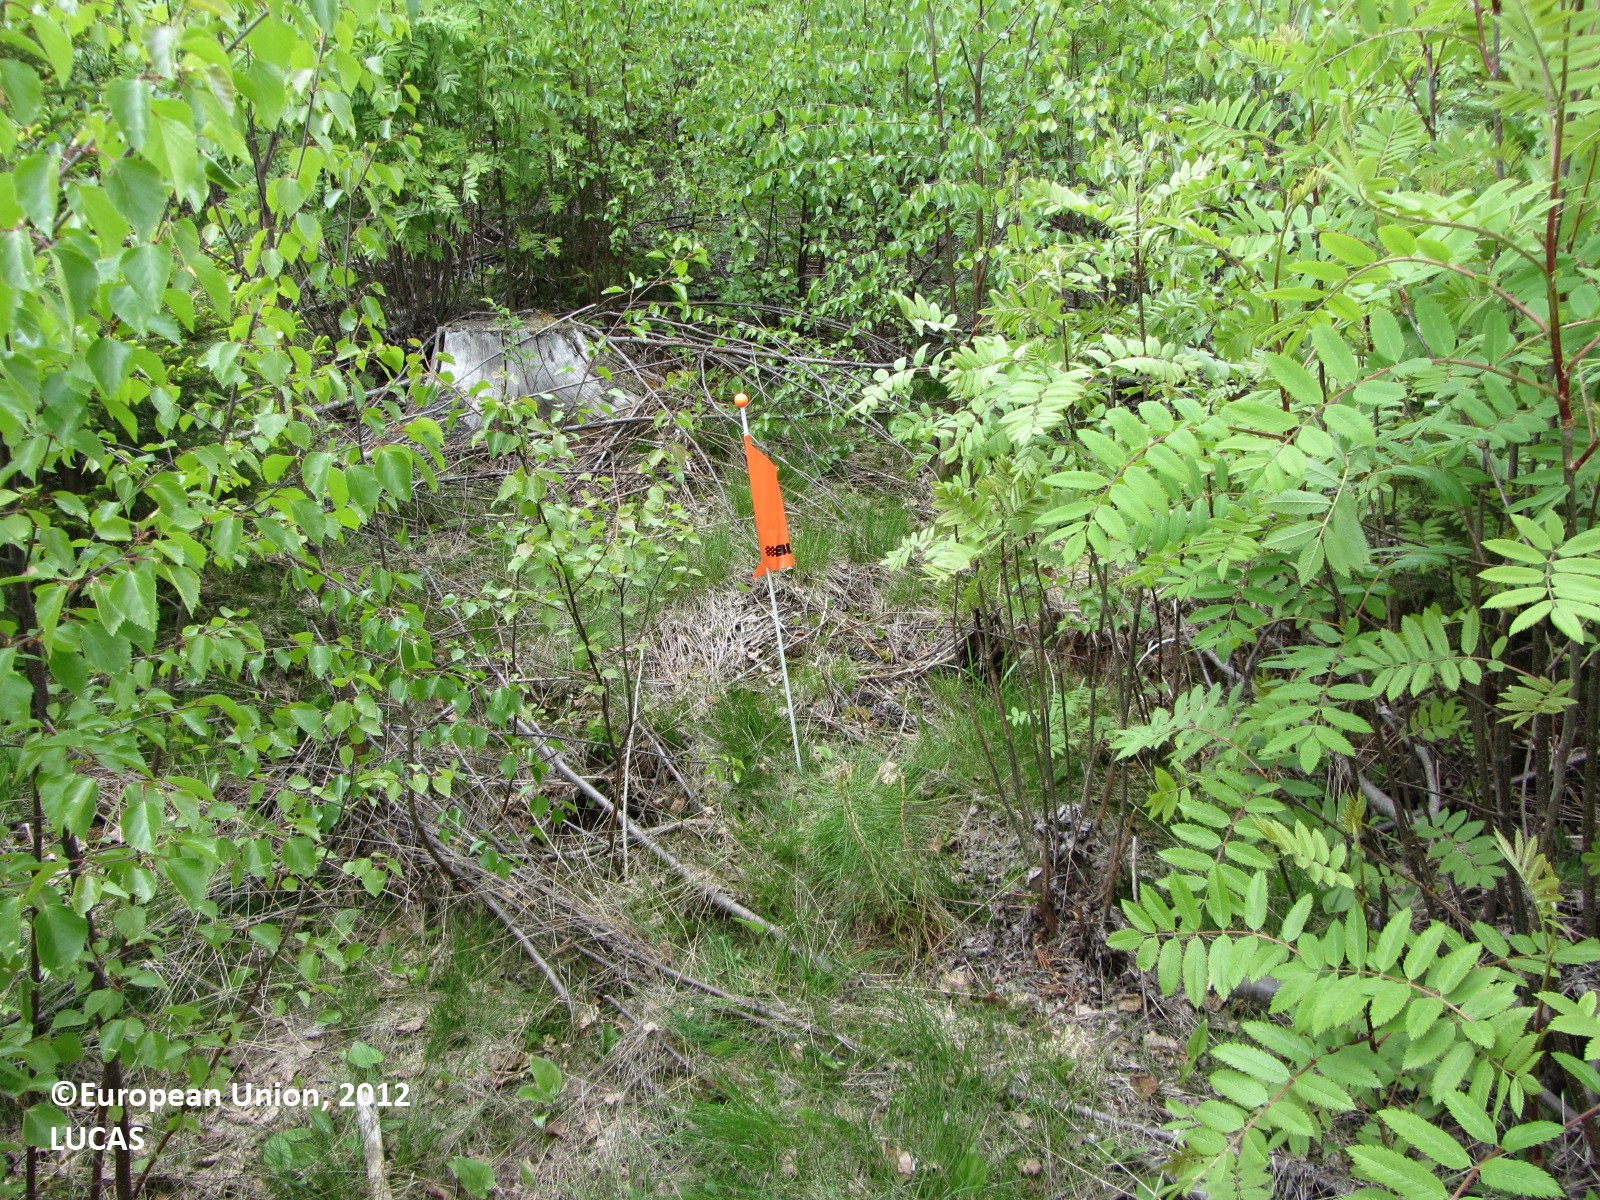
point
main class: Woodland
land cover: Spruce dominated mixed woodland
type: boreal forest
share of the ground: > 75 %
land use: Forestry
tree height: < 5 m
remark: Nursery
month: May
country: FI
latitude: 62.2360
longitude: 25.4102
